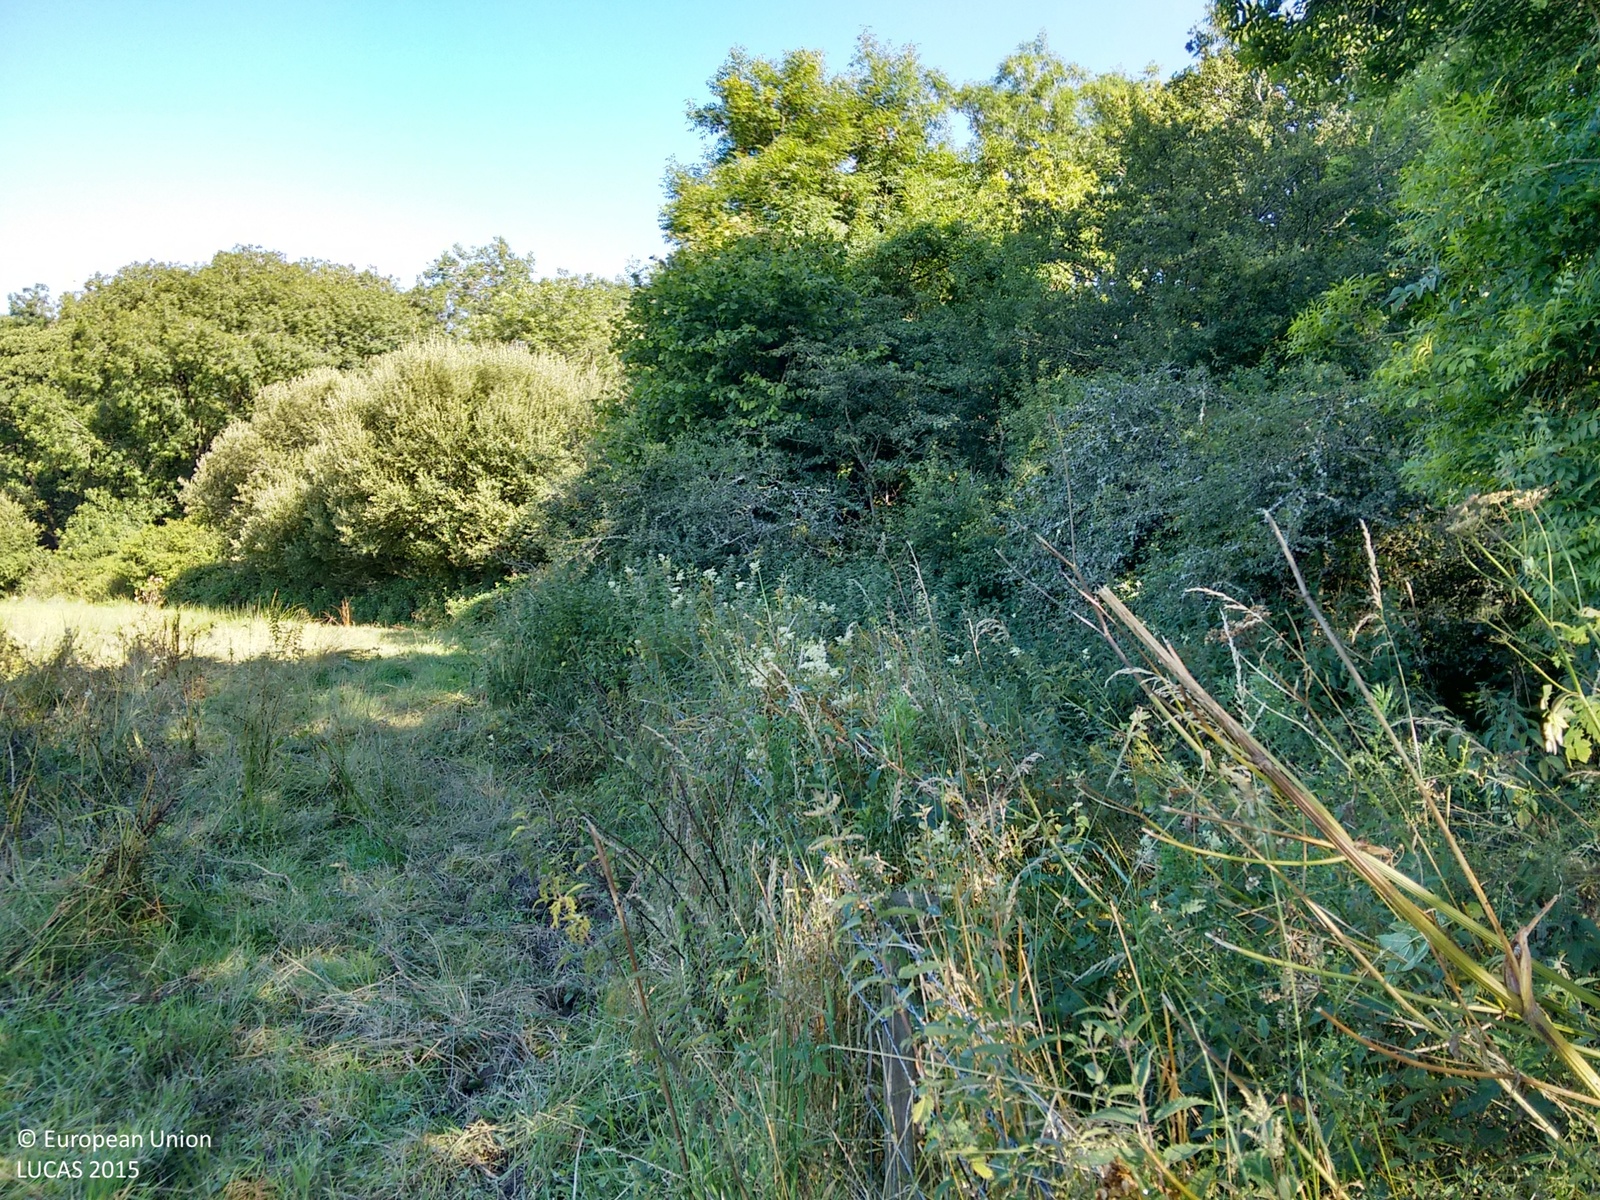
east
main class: Woodland
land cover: Broadleaved woodland
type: mesophytic deciduous forest
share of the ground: > 75 %
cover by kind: broadleaved forest trees 70 %, shrubs 30 %
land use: Semi-natural and natural areas not in use
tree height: > 5 m
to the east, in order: Broadleaved woodland; Rivers and streams; Broadleaved woodland
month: August
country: GB
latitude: 51.6990
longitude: -4.7981
